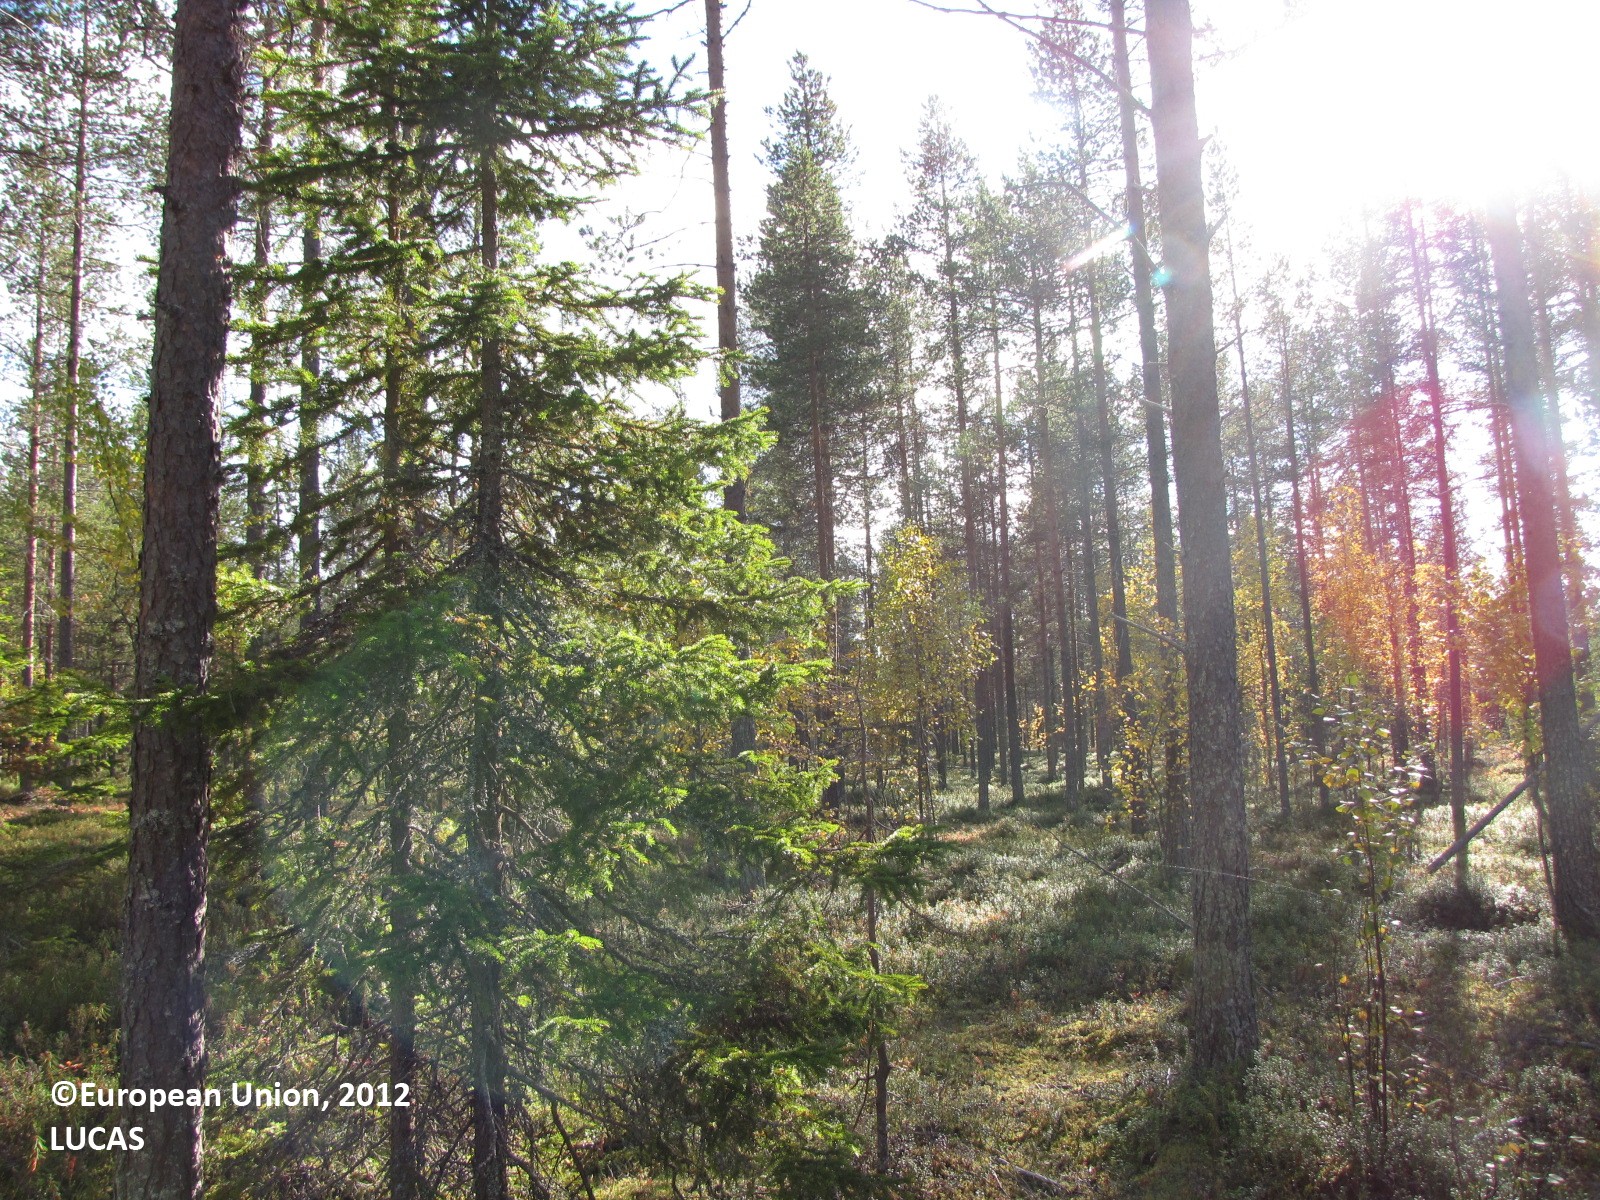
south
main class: Woodland
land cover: Pine dominated coniferous woodland
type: boreal forest
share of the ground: 25 - 50 %
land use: Forestry
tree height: > 5 m
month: September
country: FI
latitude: 67.2963
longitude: 24.8761
